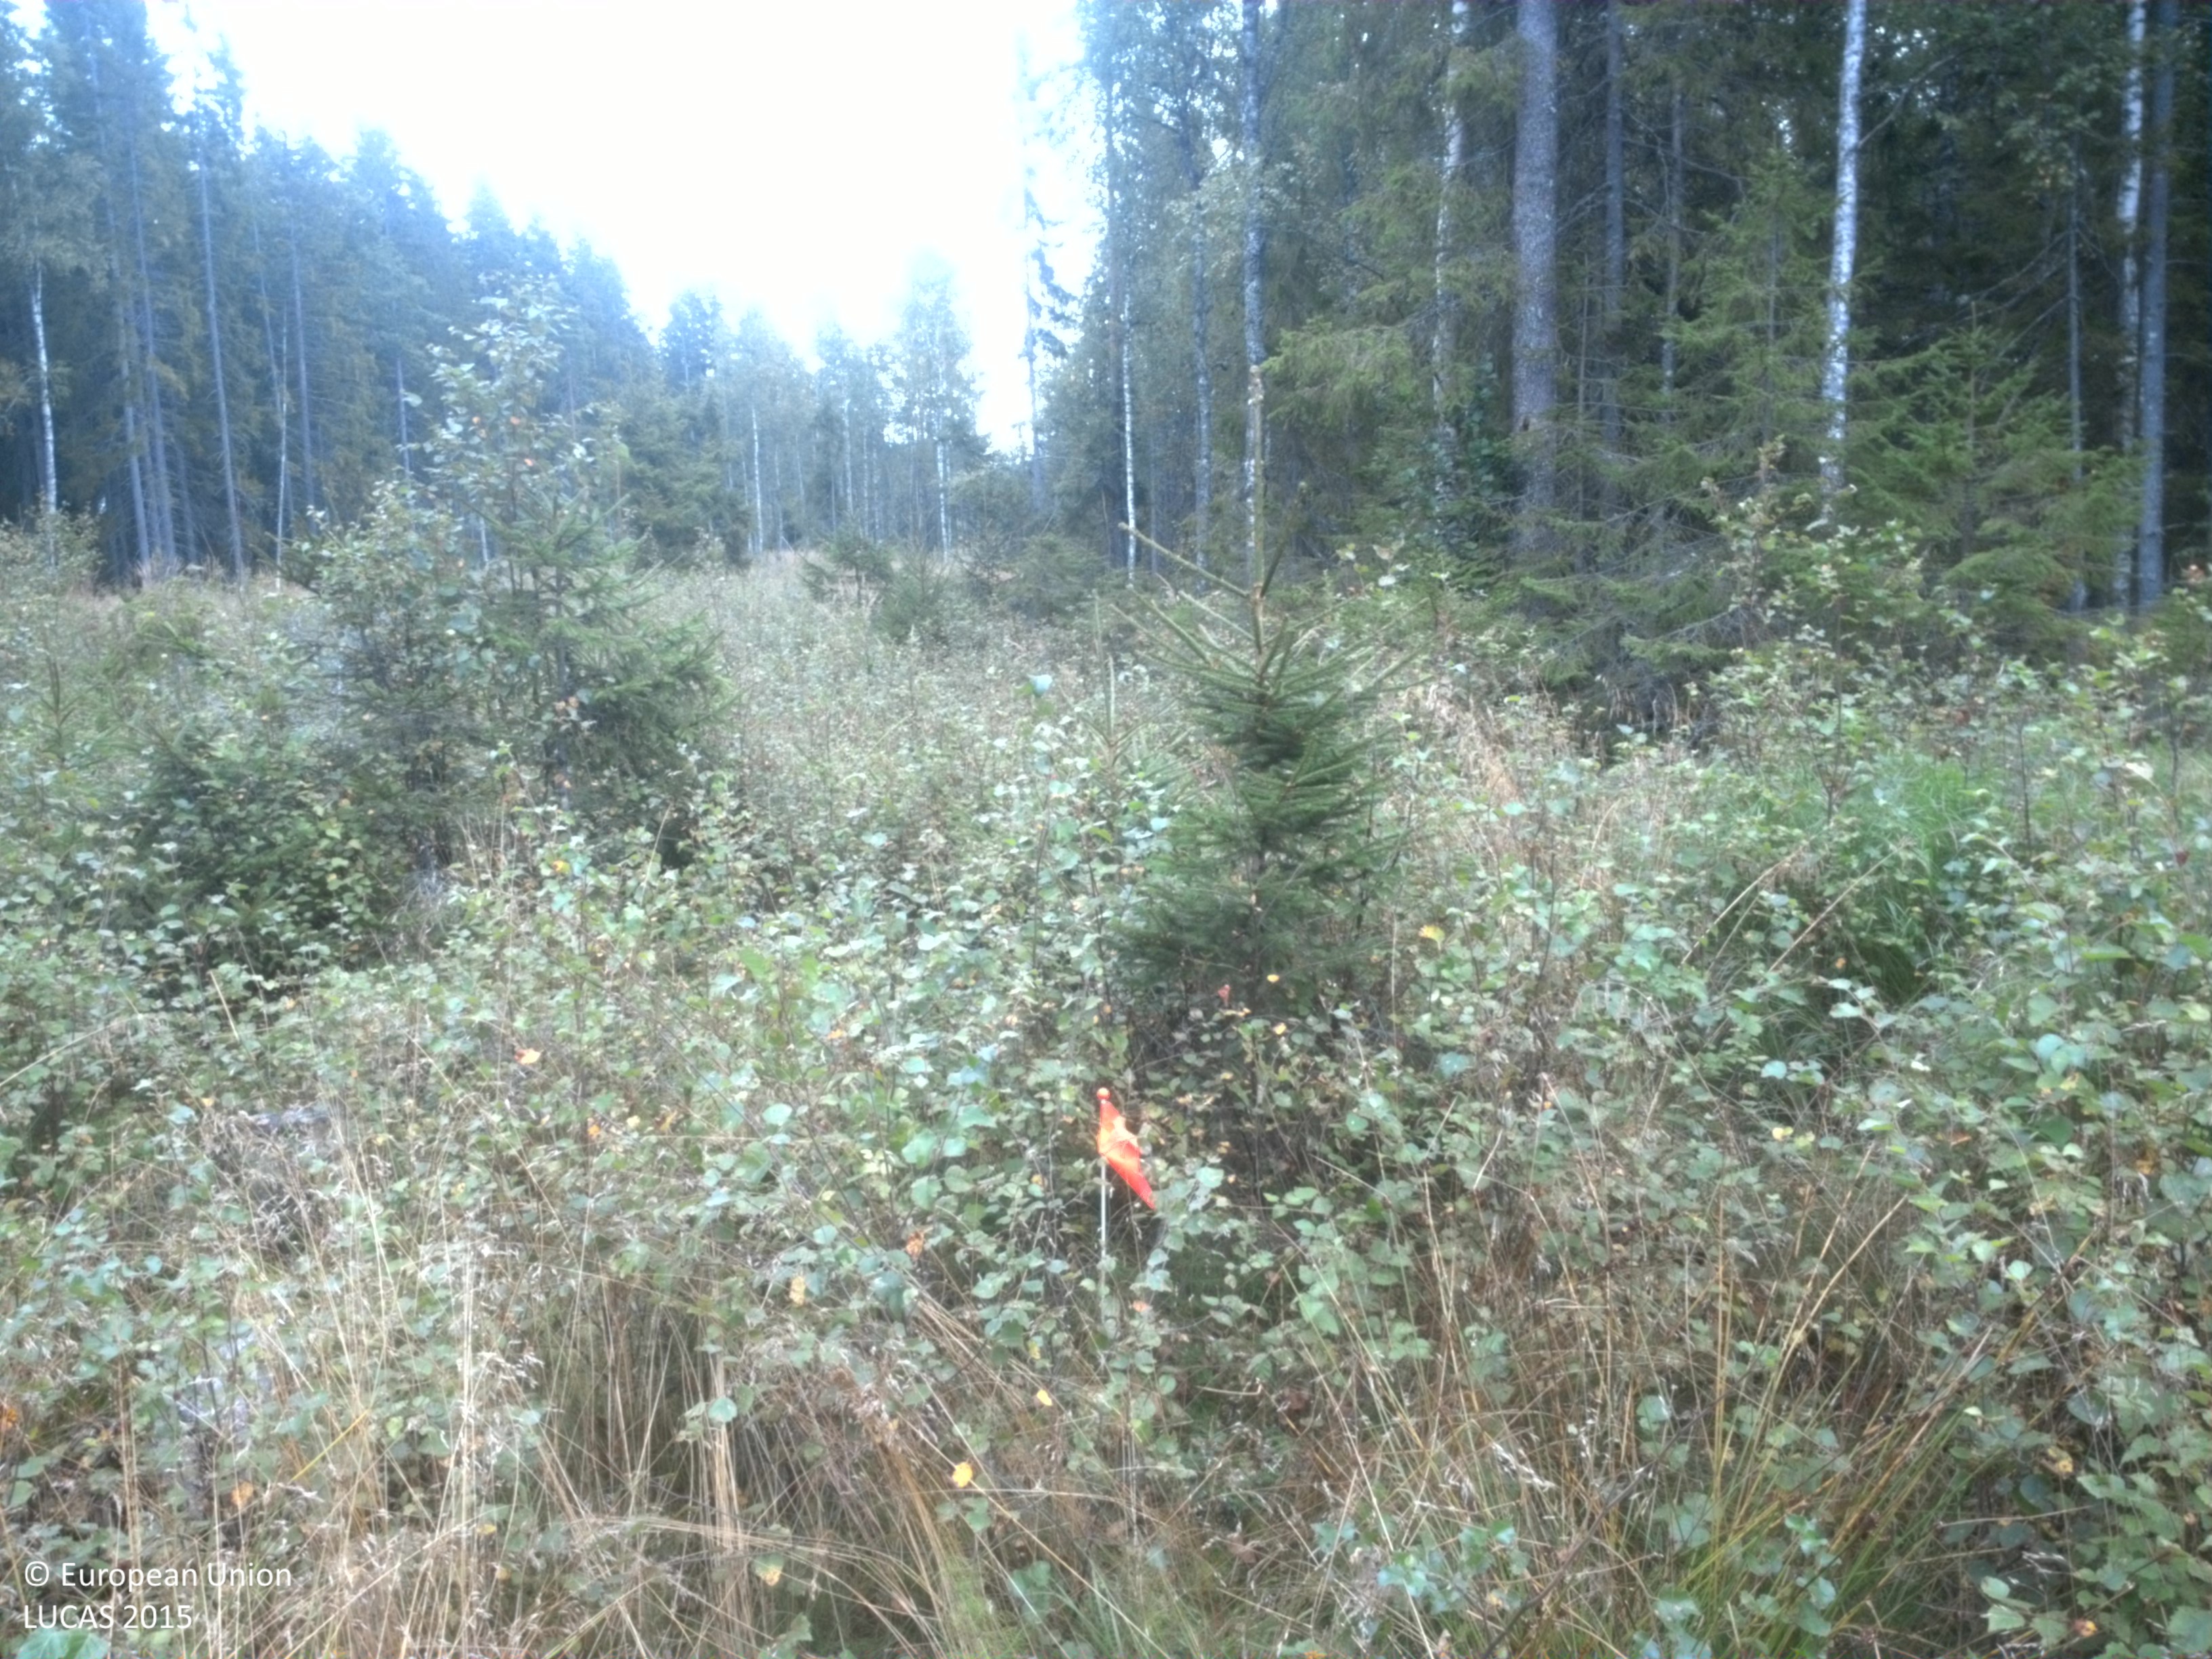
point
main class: Woodland
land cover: Spruce dominated mixed woodland
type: boreal forest
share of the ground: > 75 %
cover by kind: broadleaved forest trees 55 %, coniferous forest trees 20 %, herbaceous plants 20 %, shrubs 5 %
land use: Forestry
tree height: < 5 m
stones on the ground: < 10 %
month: August
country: SE
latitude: 59.6853
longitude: 15.7277
